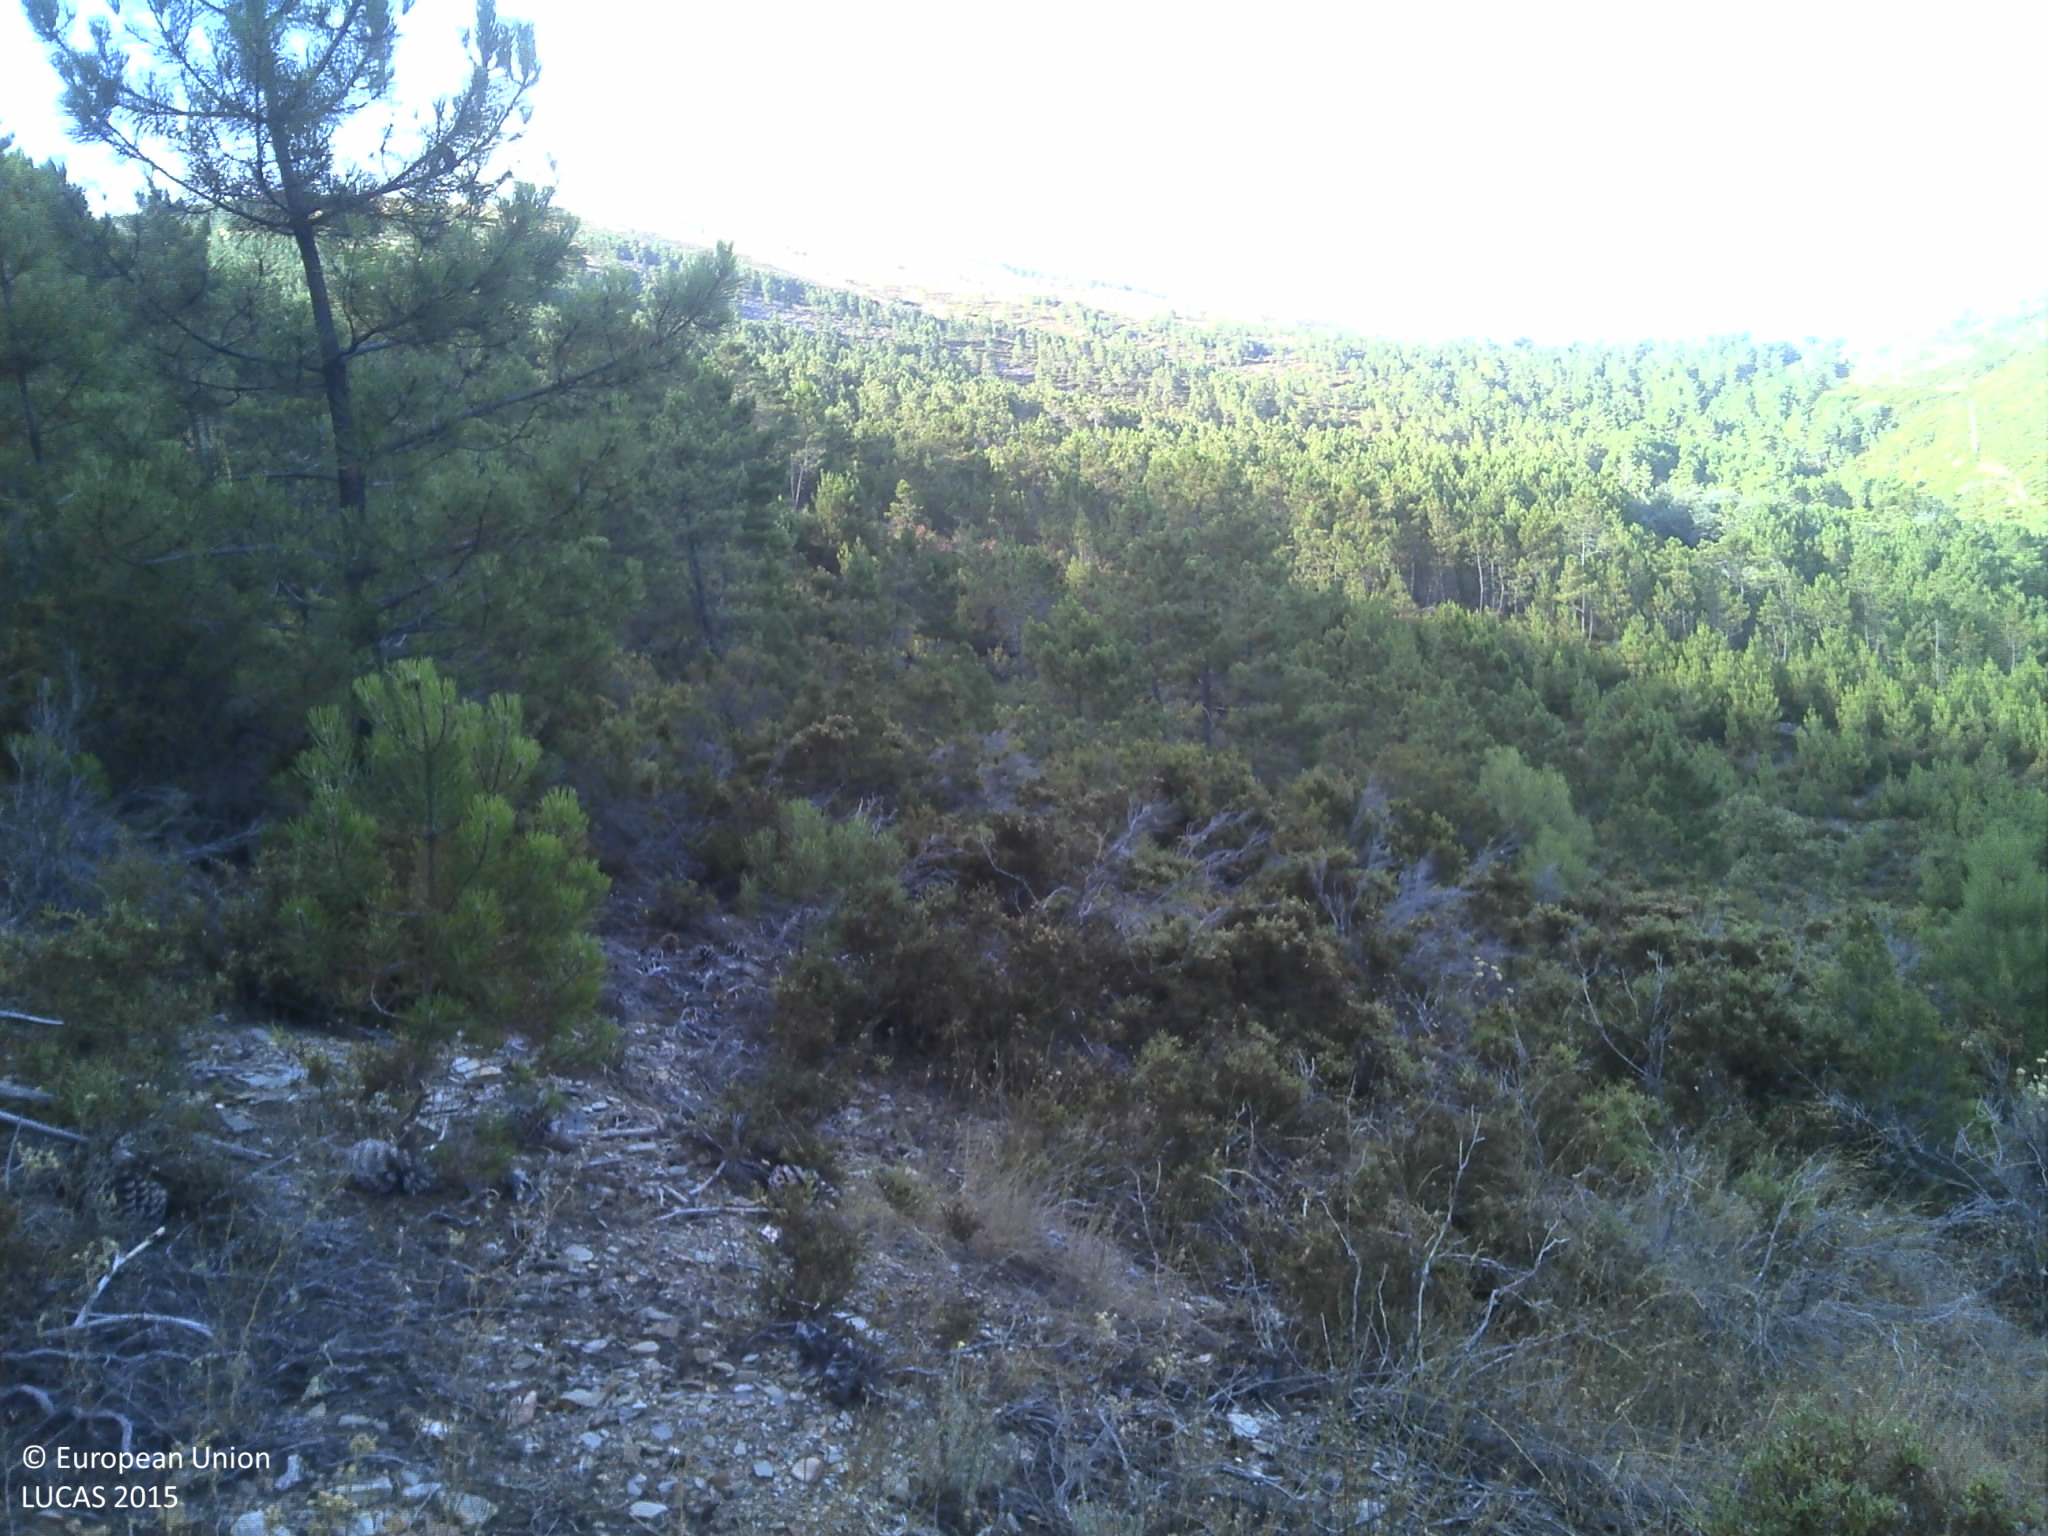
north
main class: Shrubland
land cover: Shrubland with sparse tree cover
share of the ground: 25 - 50 %
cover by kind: unconsolidated bare surface 55 %, shrubs 30 %, herbaceous plants 10 %, coniferous forest trees 5 %
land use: Abandoned areas
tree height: < 5 m
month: July
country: PT
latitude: 40.1568
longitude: -7.8052
